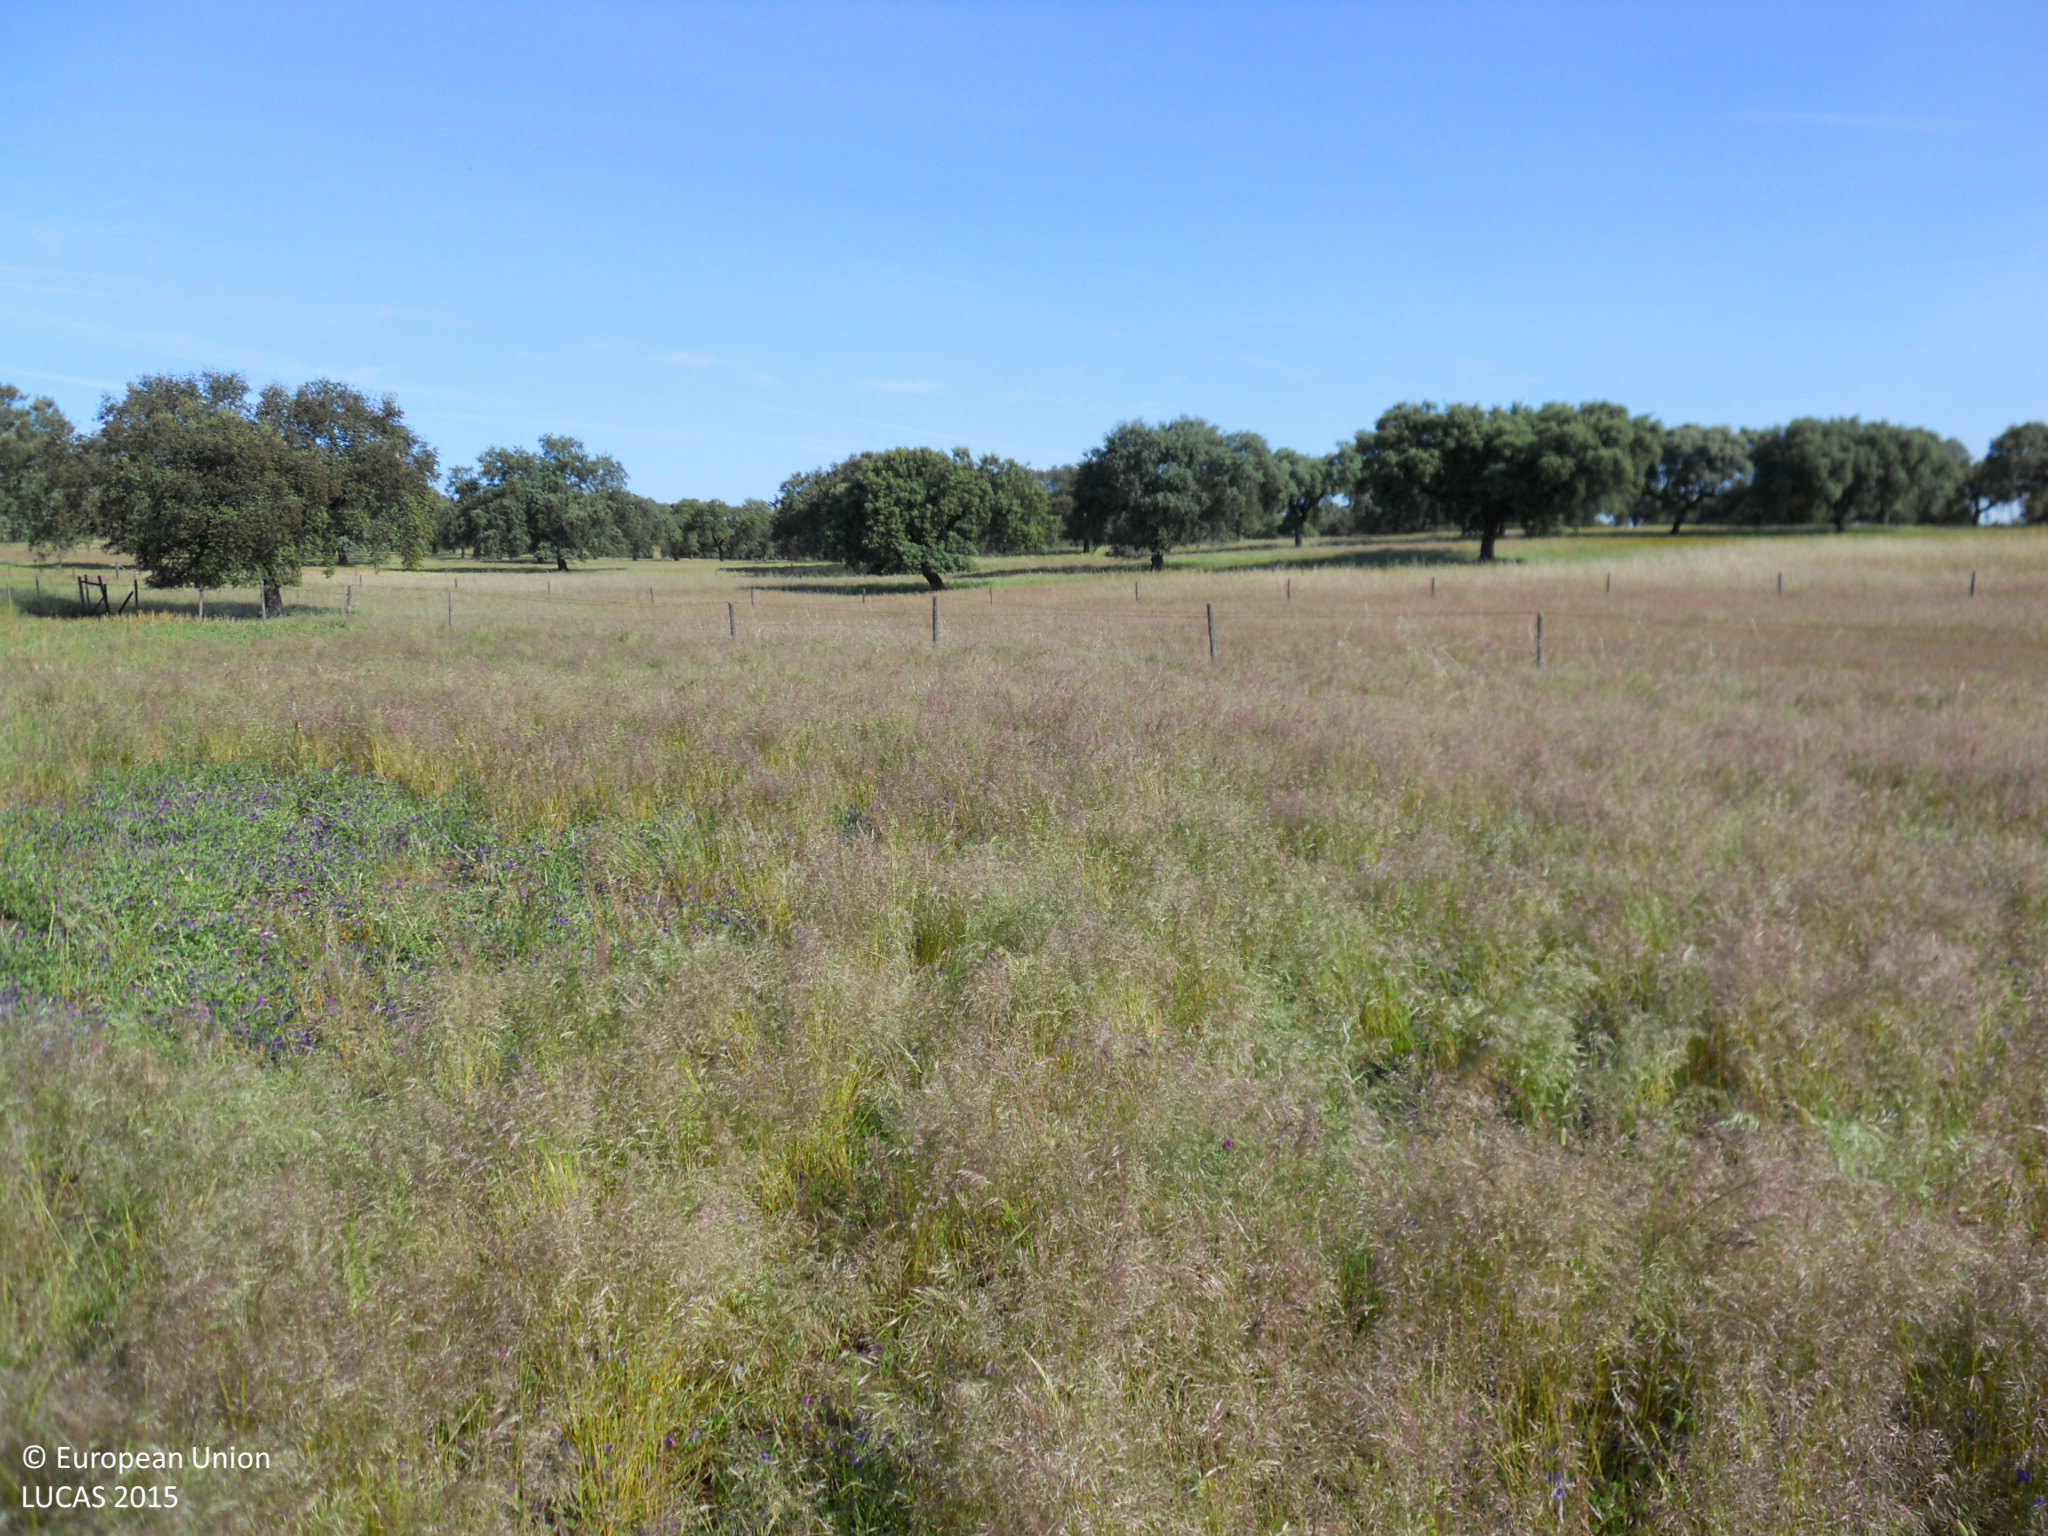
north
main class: Grassland
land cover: Grassland with sparse tree/shrub cover
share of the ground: > 75 %
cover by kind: herbaceous plants 95 %, broadleaved forest trees 5 %
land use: Agriculture (excluding fallow land and kitchen gardens)
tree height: > 5 m
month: April
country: ES
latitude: 39.0543
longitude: -6.8609
